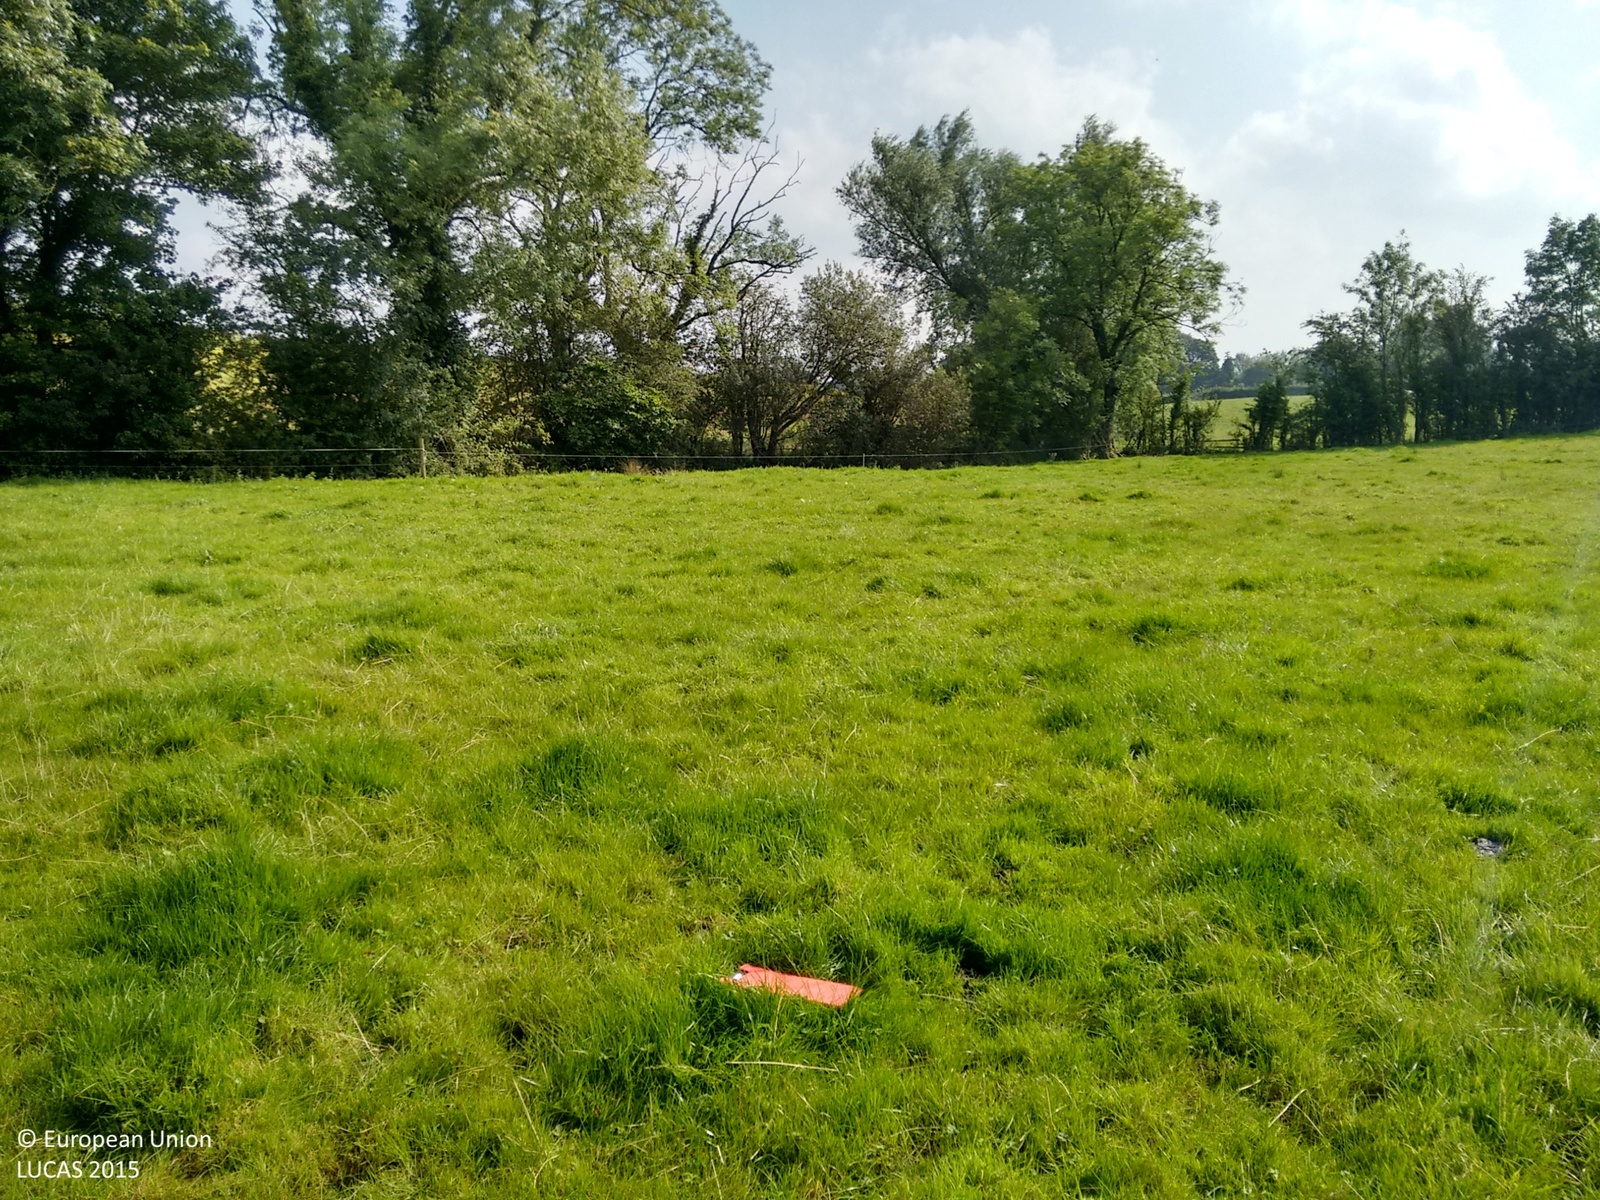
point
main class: Grassland
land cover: Grassland without tree/shrub cover
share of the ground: > 75 %
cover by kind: herbaceous plants 100 %
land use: Agriculture (excluding fallow land and kitchen gardens)
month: September
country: IE
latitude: 54.2690
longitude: -6.9840
